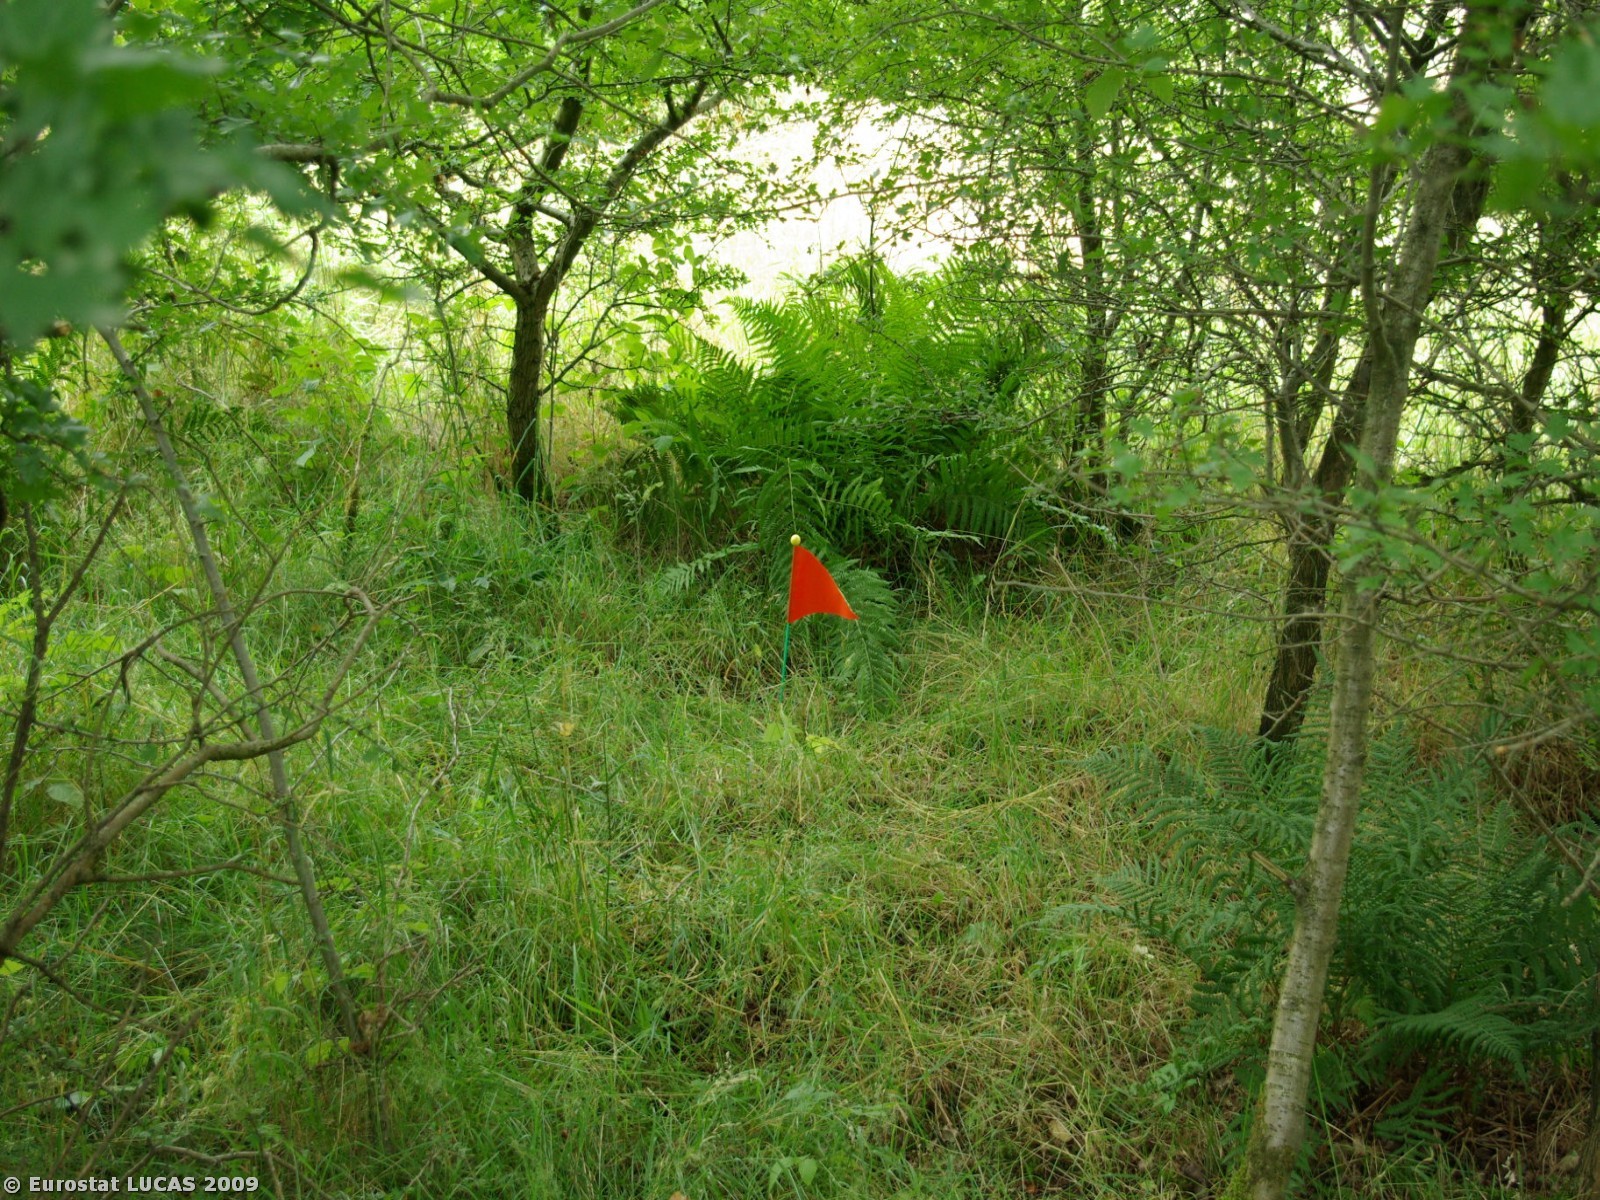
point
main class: Woodland
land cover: Broadleaved woodland
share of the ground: 50 - 75 %
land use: Unused
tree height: > 5 m
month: July
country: DK
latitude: 55.2331
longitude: 9.2930
